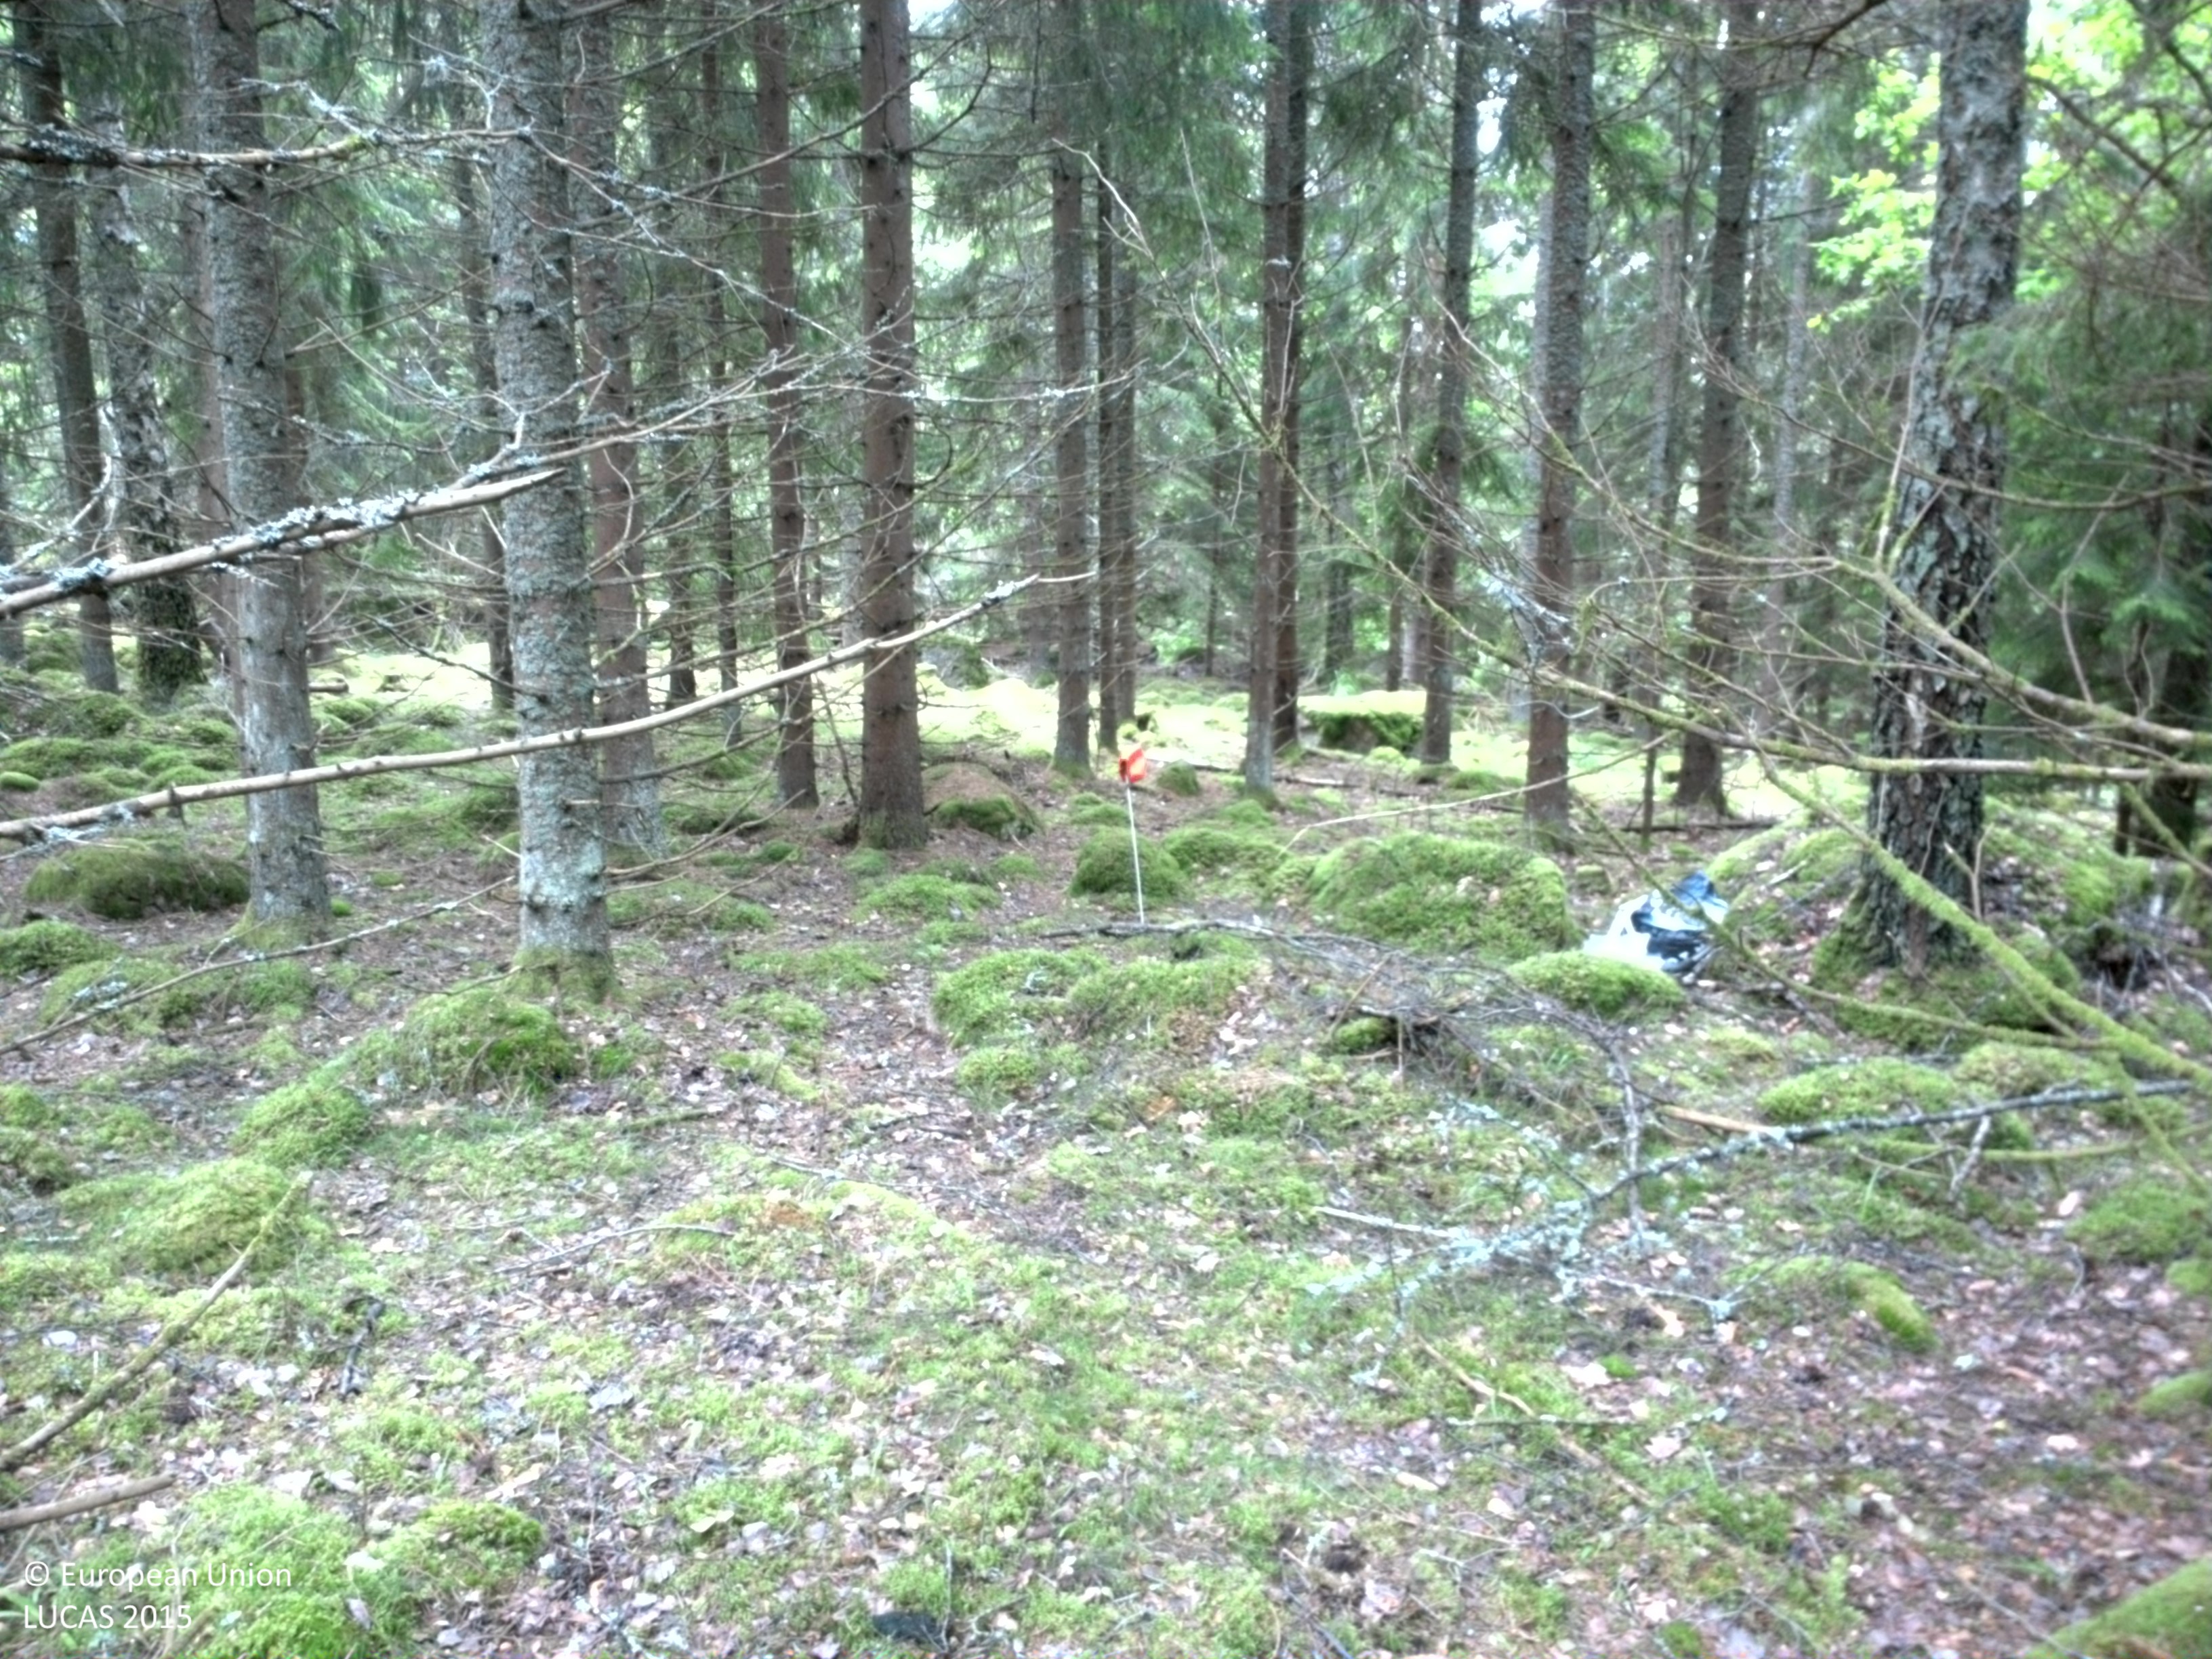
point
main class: Woodland
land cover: Spruce dominated coniferous woodland
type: boreal forest
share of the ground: 50 - 75 %
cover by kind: coniferous forest trees 70 %, lichens and mosses 30 %
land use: Forestry
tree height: > 5 m
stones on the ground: 10 - 25 %
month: June
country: SE
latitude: 58.5367
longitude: 15.5767
